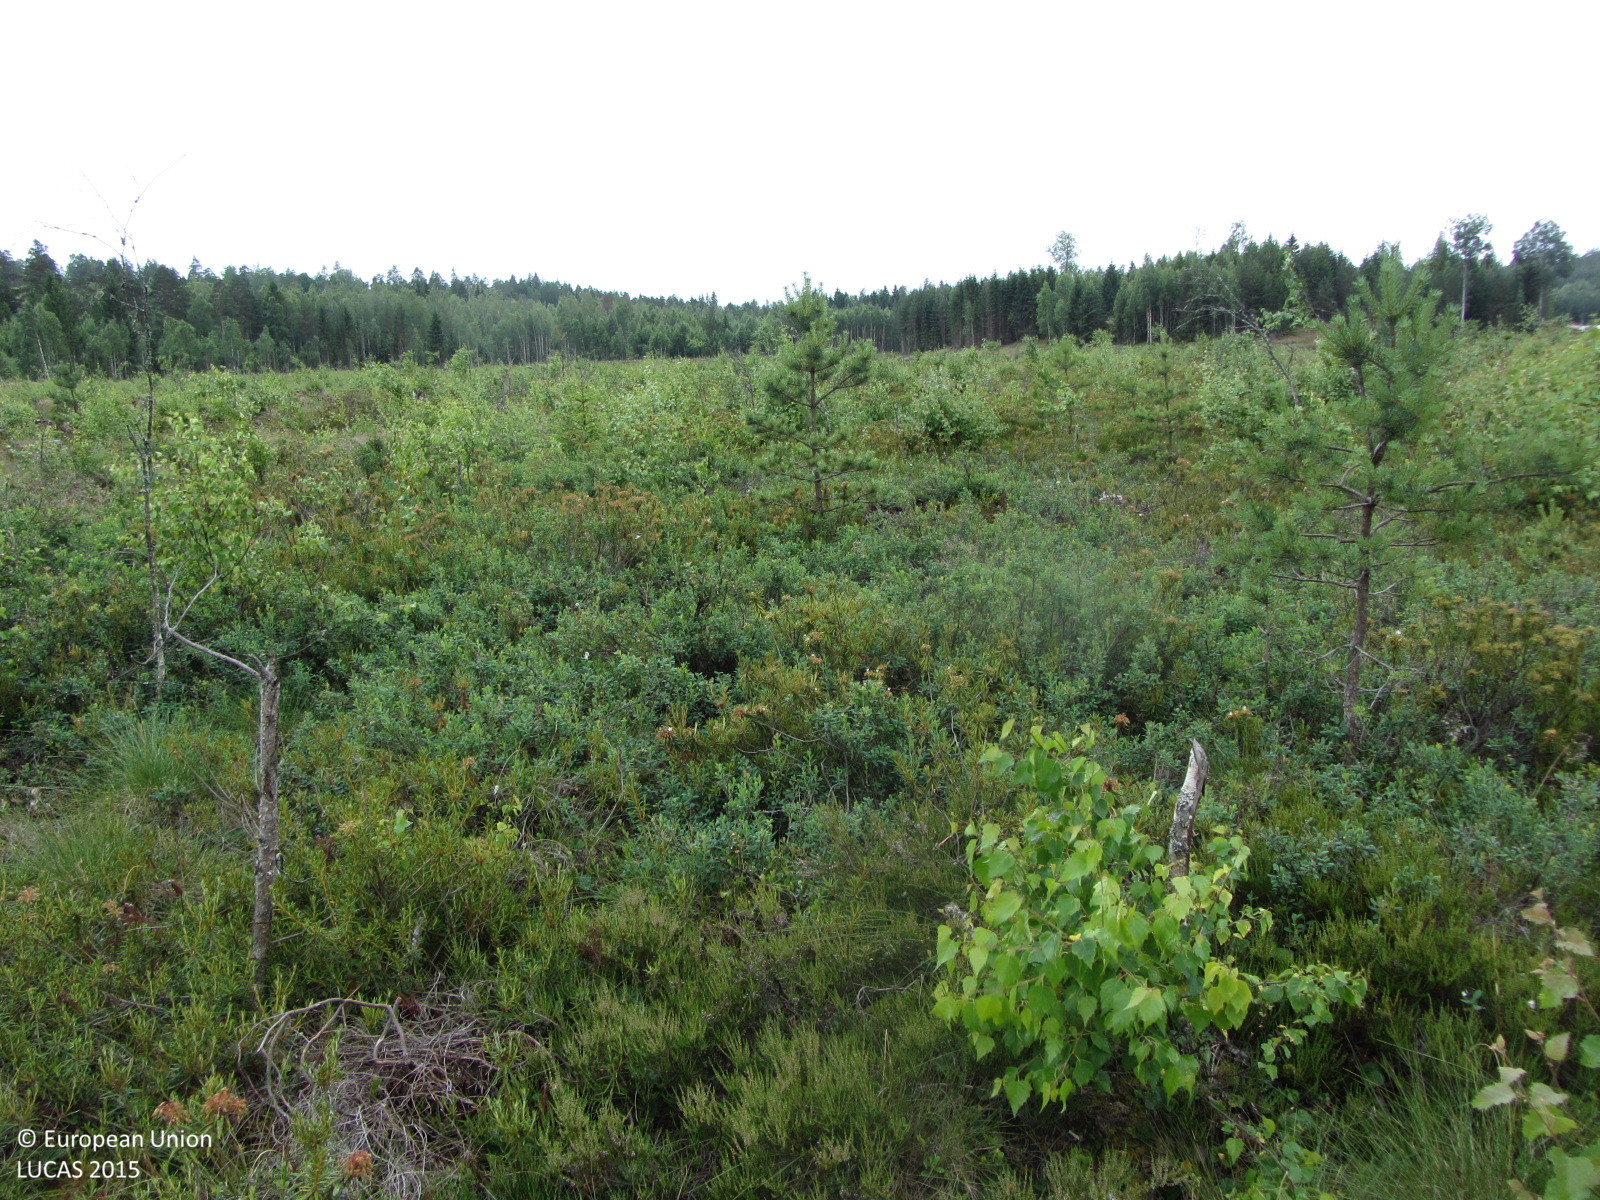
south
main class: Woodland
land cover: Broadleaved woodland
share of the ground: 25 - 50 %
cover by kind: shrubs 50 %, broadleaved forest trees 40 %, coniferous forest trees 5 %, herbaceous plants 5 %
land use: Forestry
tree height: < 5 m
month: July
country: FI
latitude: 60.0338
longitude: 23.9363
